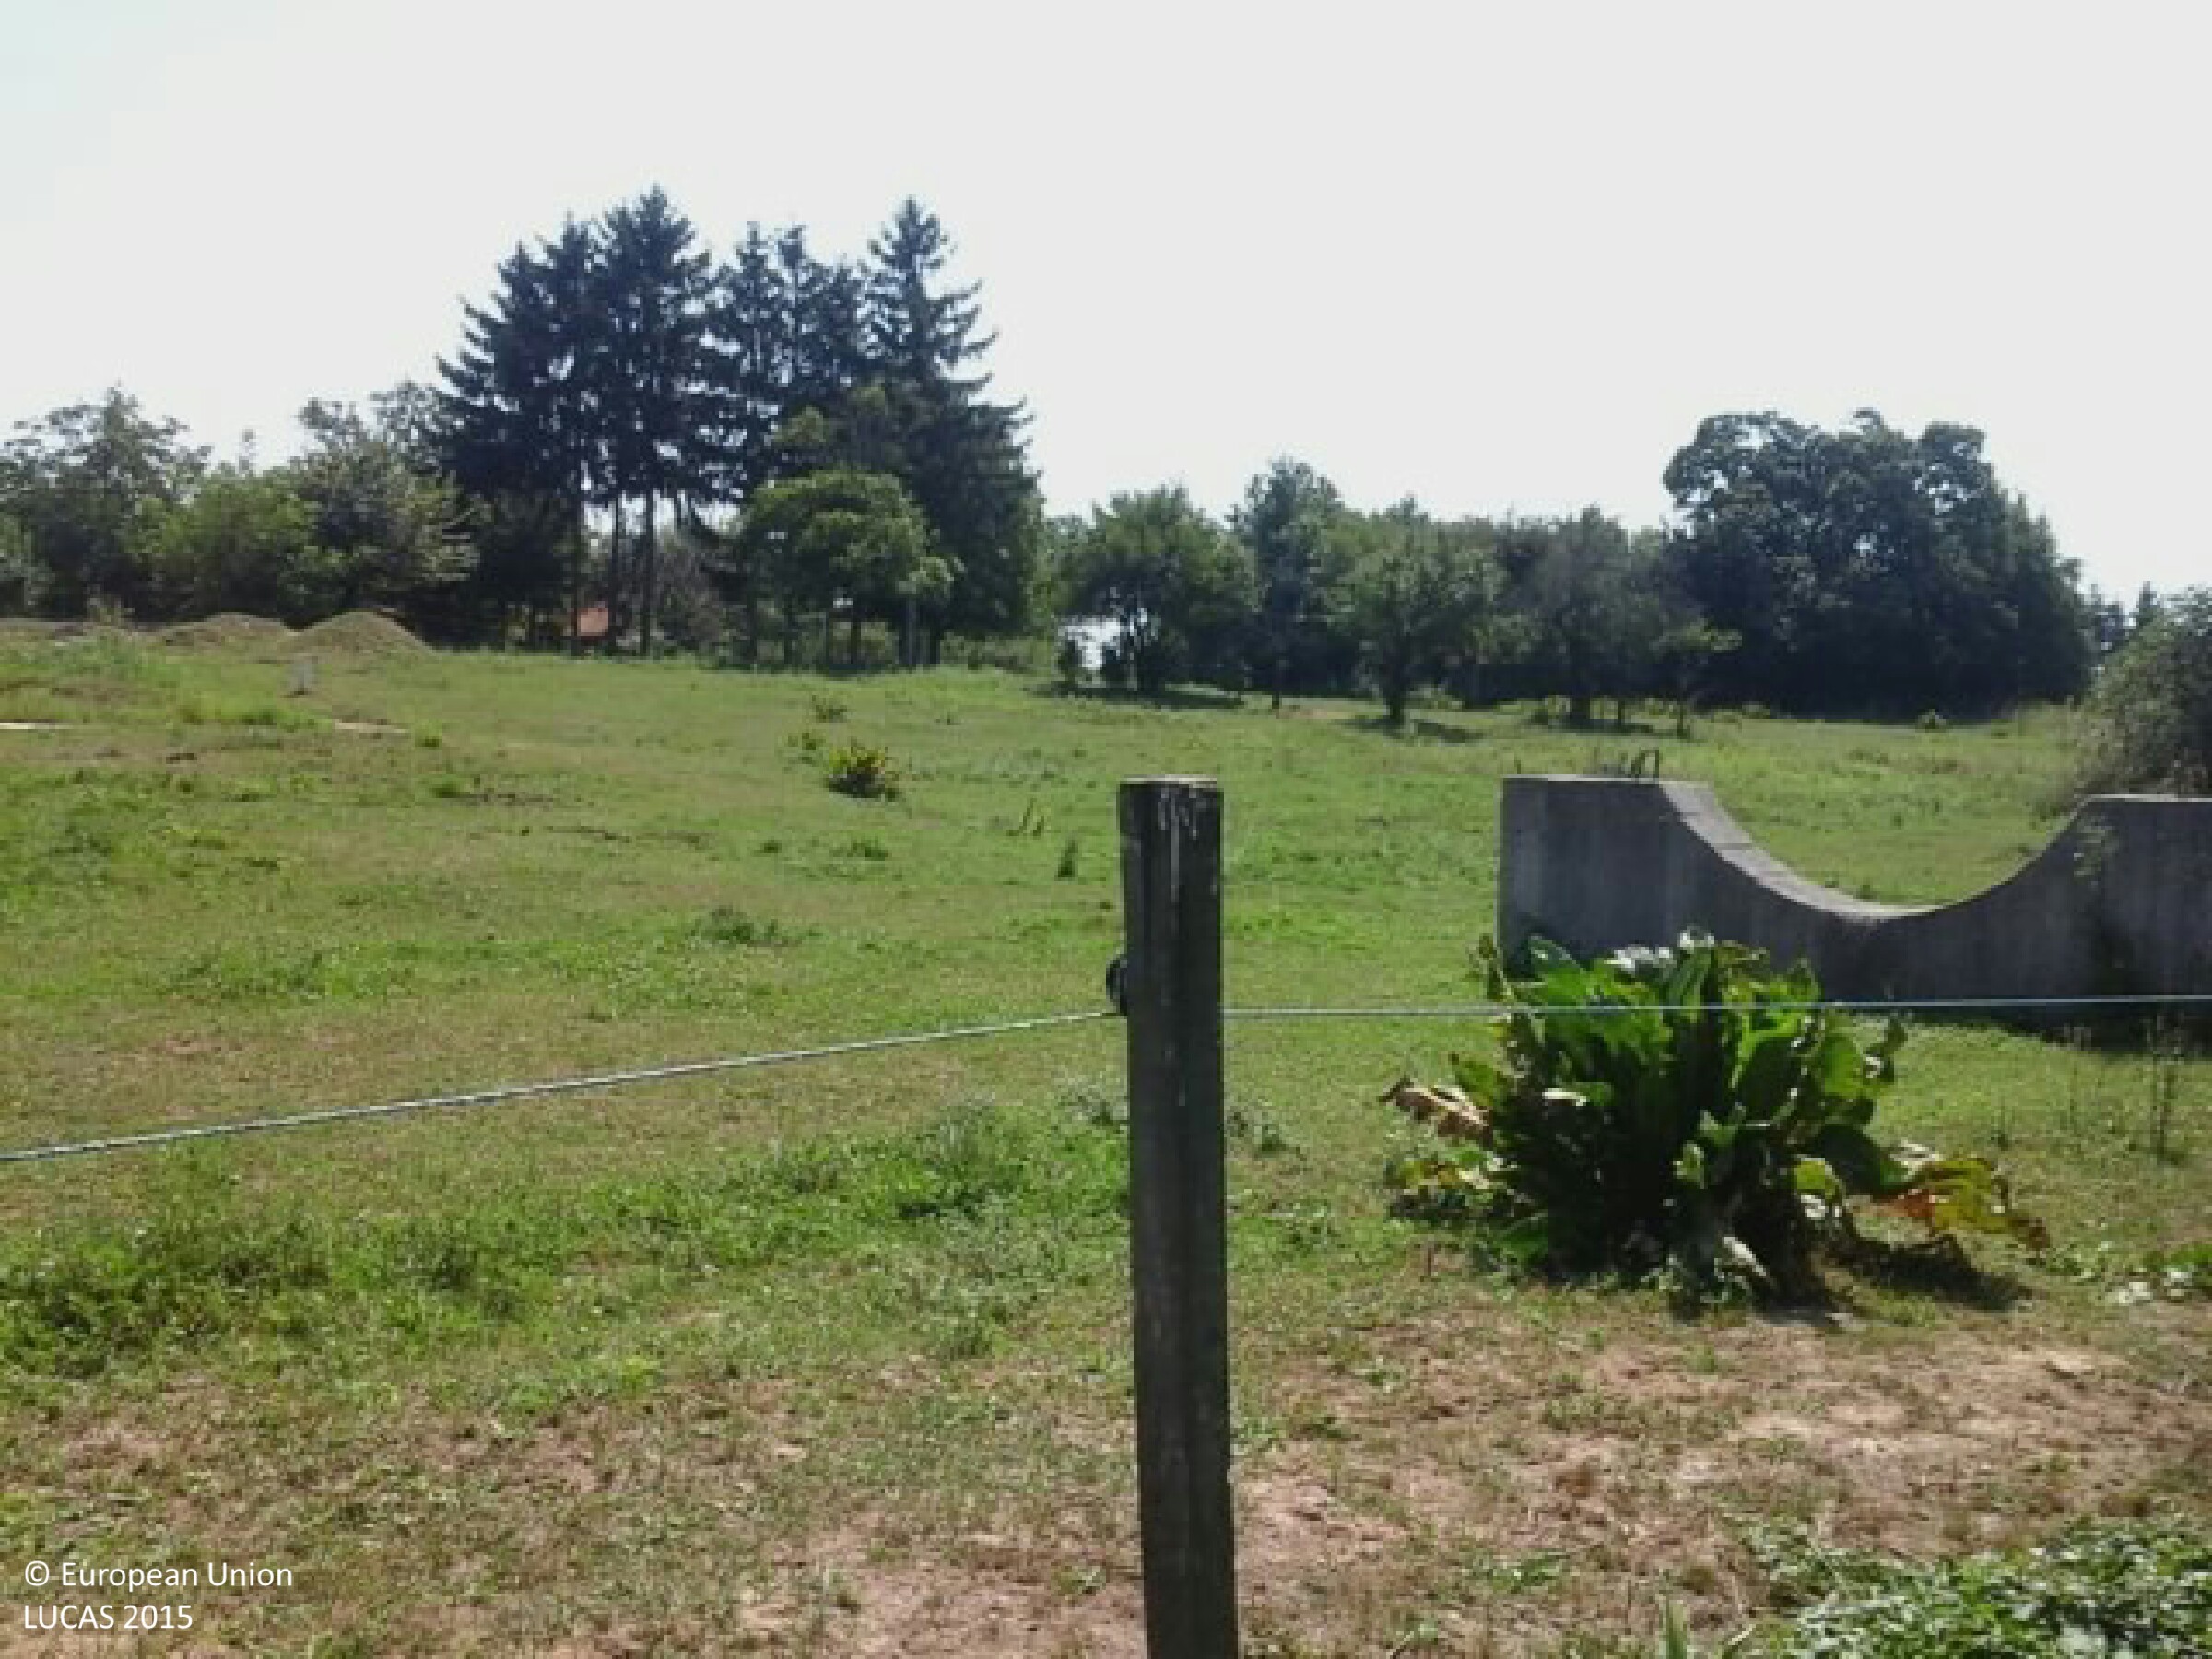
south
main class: Grassland
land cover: Grassland with sparse tree/shrub cover
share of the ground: > 75 %
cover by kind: herbaceous plants 90 %, broadleaved forest trees 5 %, shrubs 5 %
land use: Agriculture (excluding fallow land and kitchen gardens)
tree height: < 5 m
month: August
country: HU
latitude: 46.4569
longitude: 17.1252
